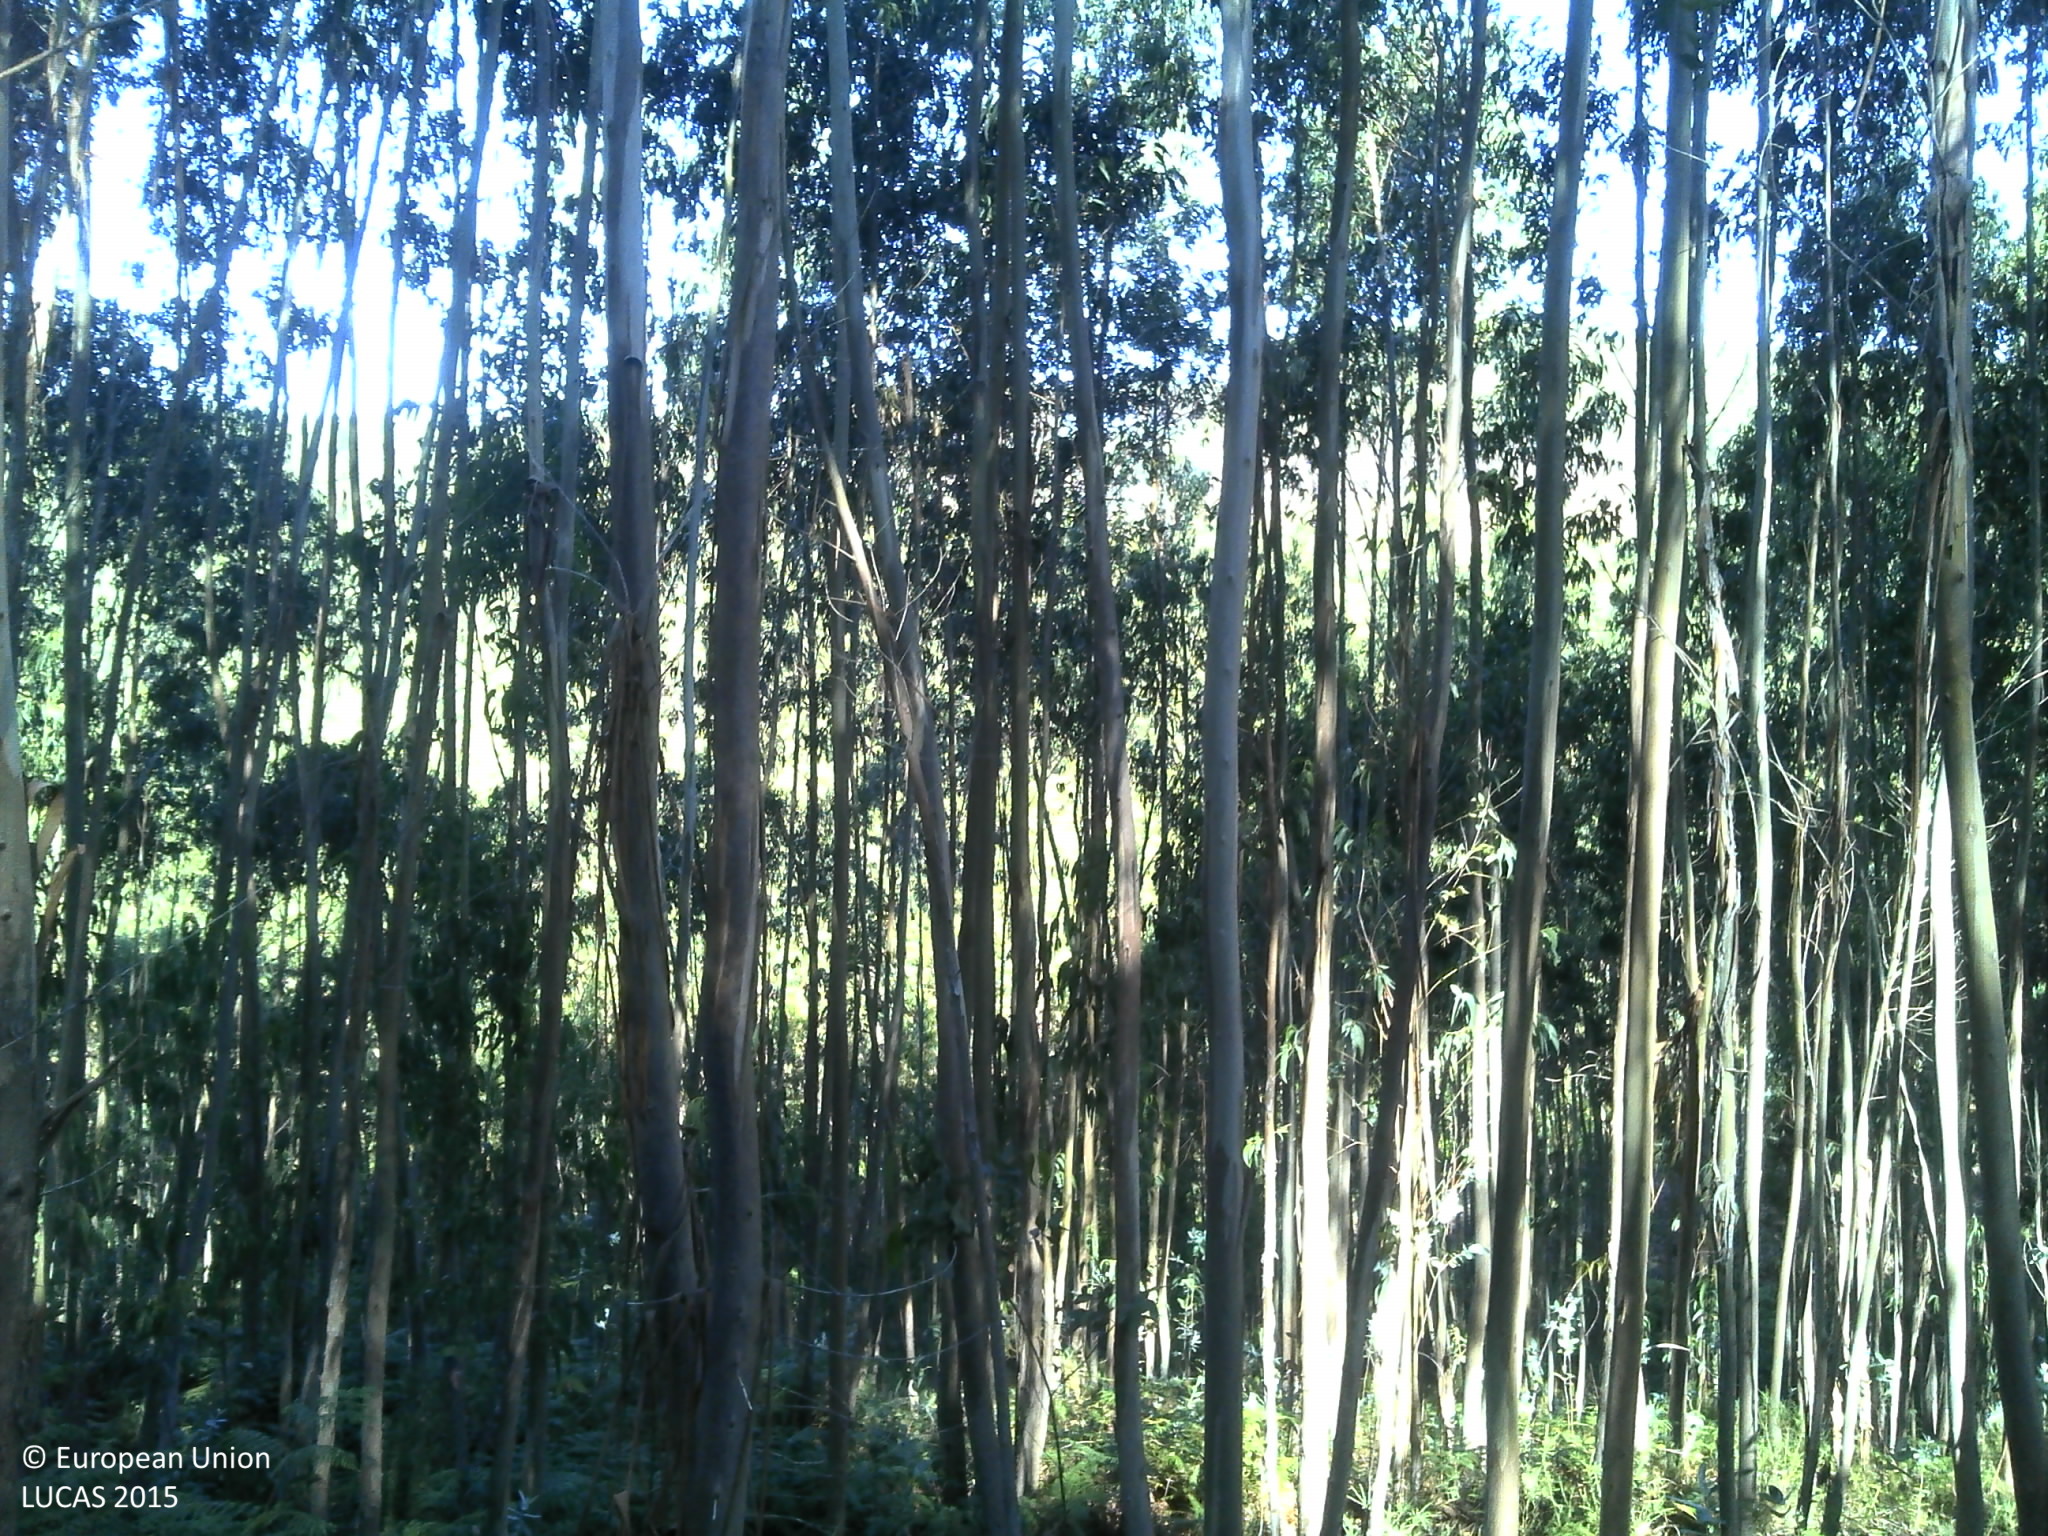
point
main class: Woodland
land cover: Broadleaved woodland
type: exotic forest
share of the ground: 50 - 75 %
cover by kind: broadleaved forest trees 75 %, shrubs 15 %, unconsolidated bare surface 10 %
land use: Forestry
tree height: > 5 m
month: June
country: PT
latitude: 40.4826
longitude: -8.2382
